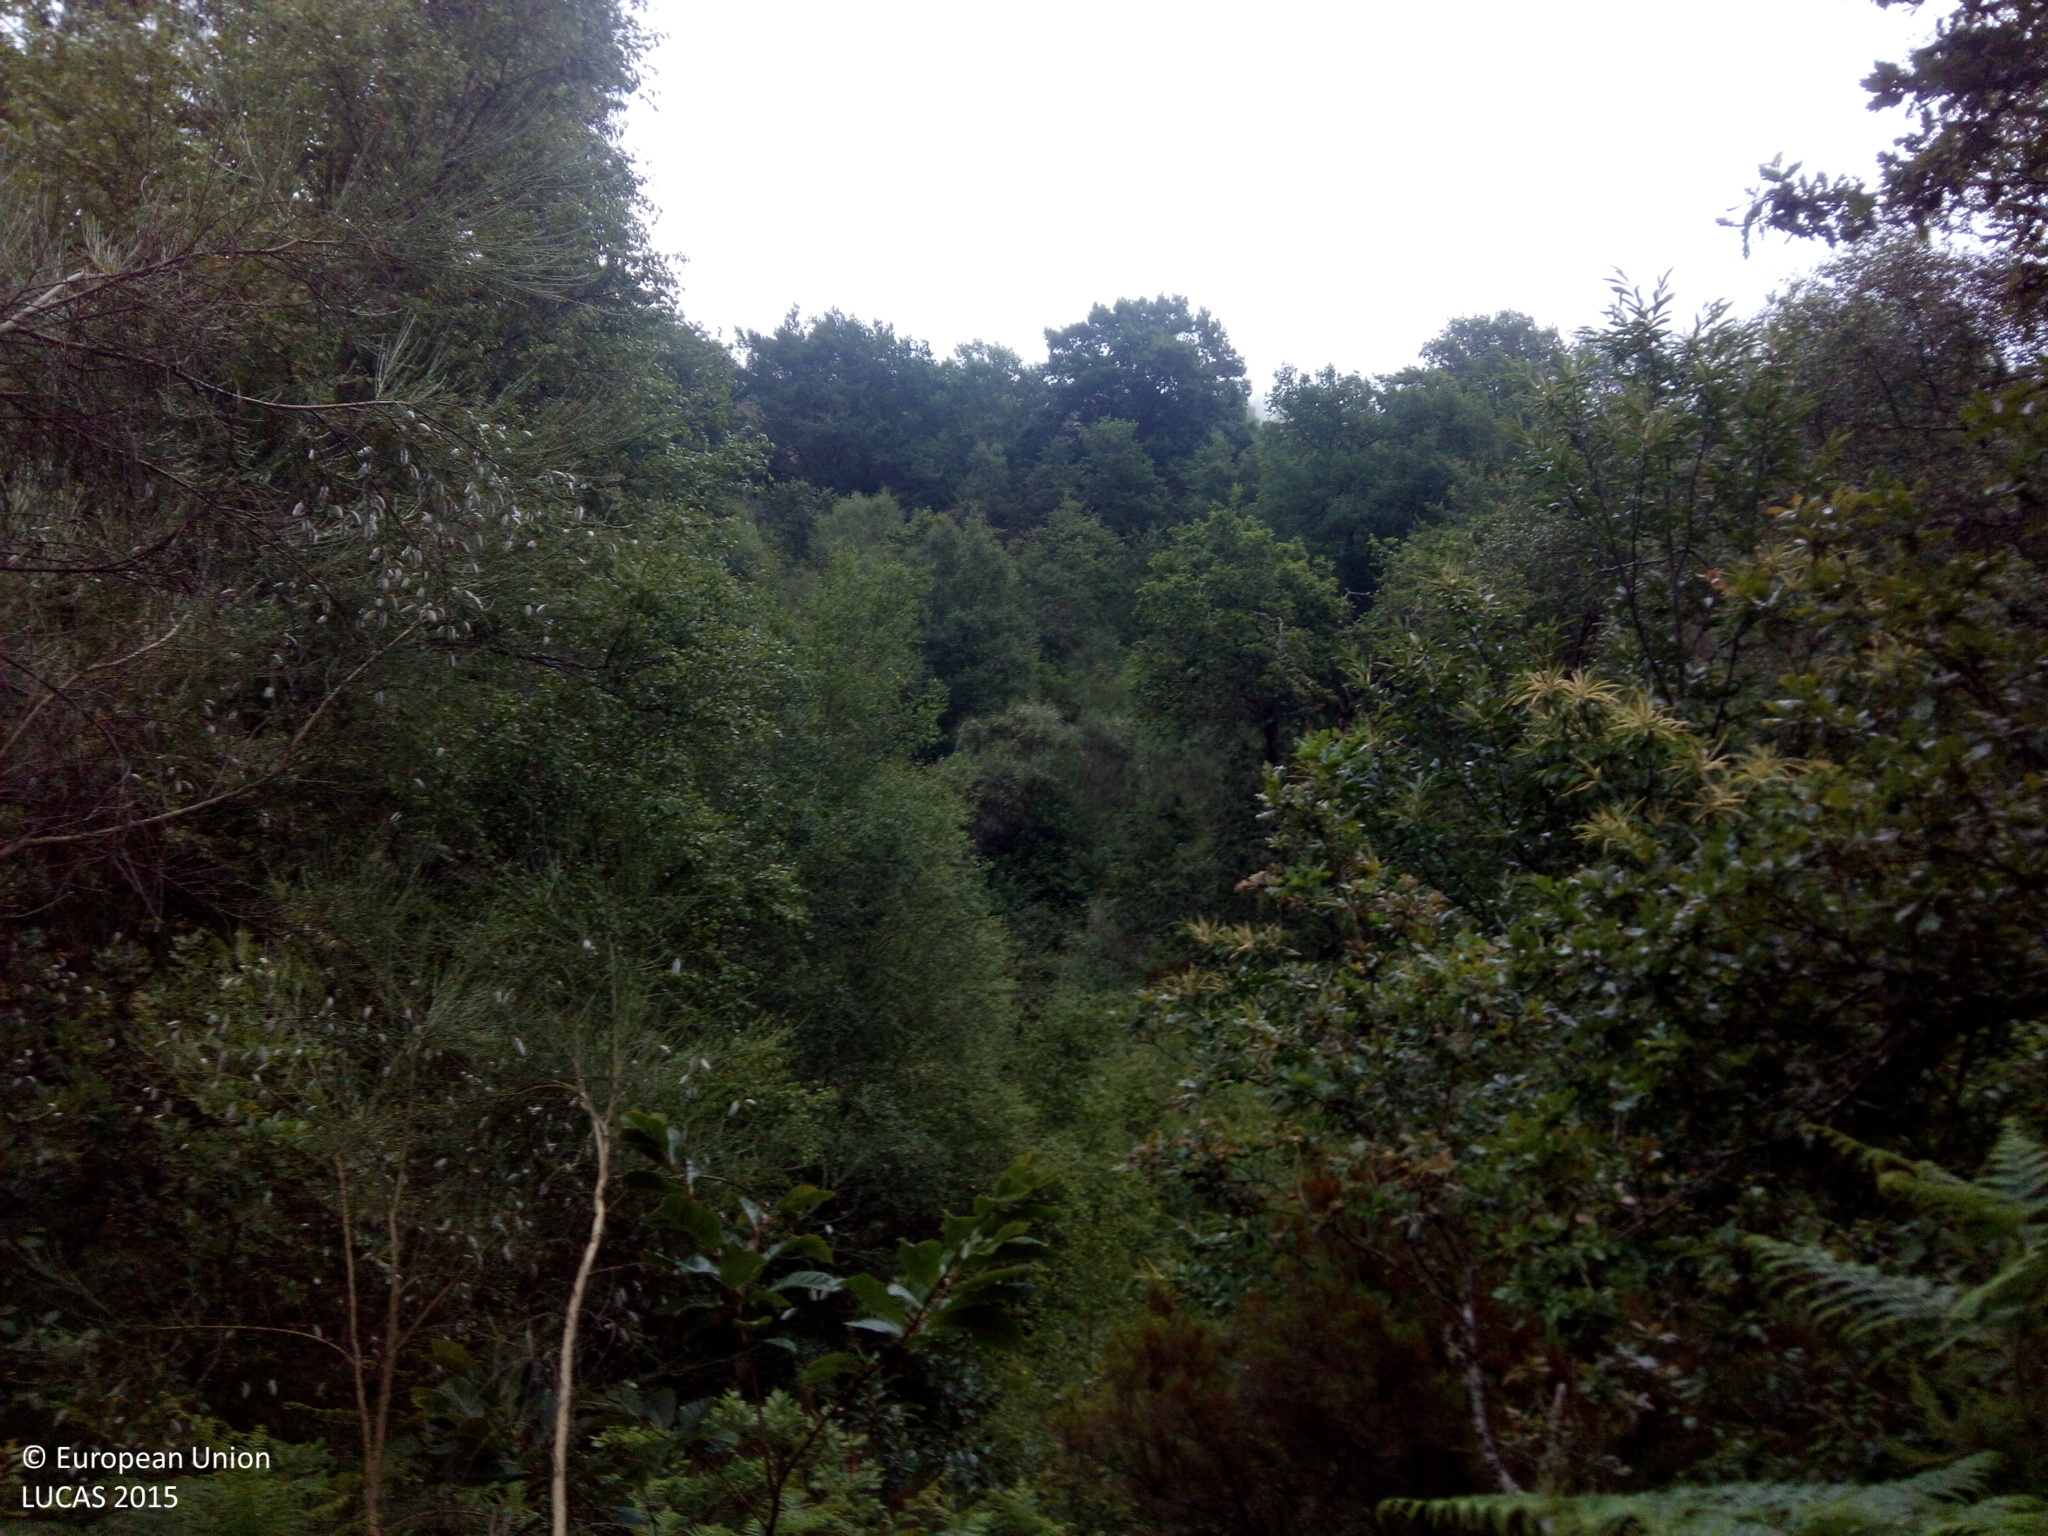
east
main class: Shrubland
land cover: Shrubland with sparse tree cover
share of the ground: > 75 %
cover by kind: shrubs 95 %, coniferous forest trees 5 %
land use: Forestry
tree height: > 5 m
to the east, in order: Shrubland with sparse tree cover; Tracks; Shrubland without tree cover; Rock outcrops; Shrubland without tree cover
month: July
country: ES
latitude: 42.2655
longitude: -8.2854
